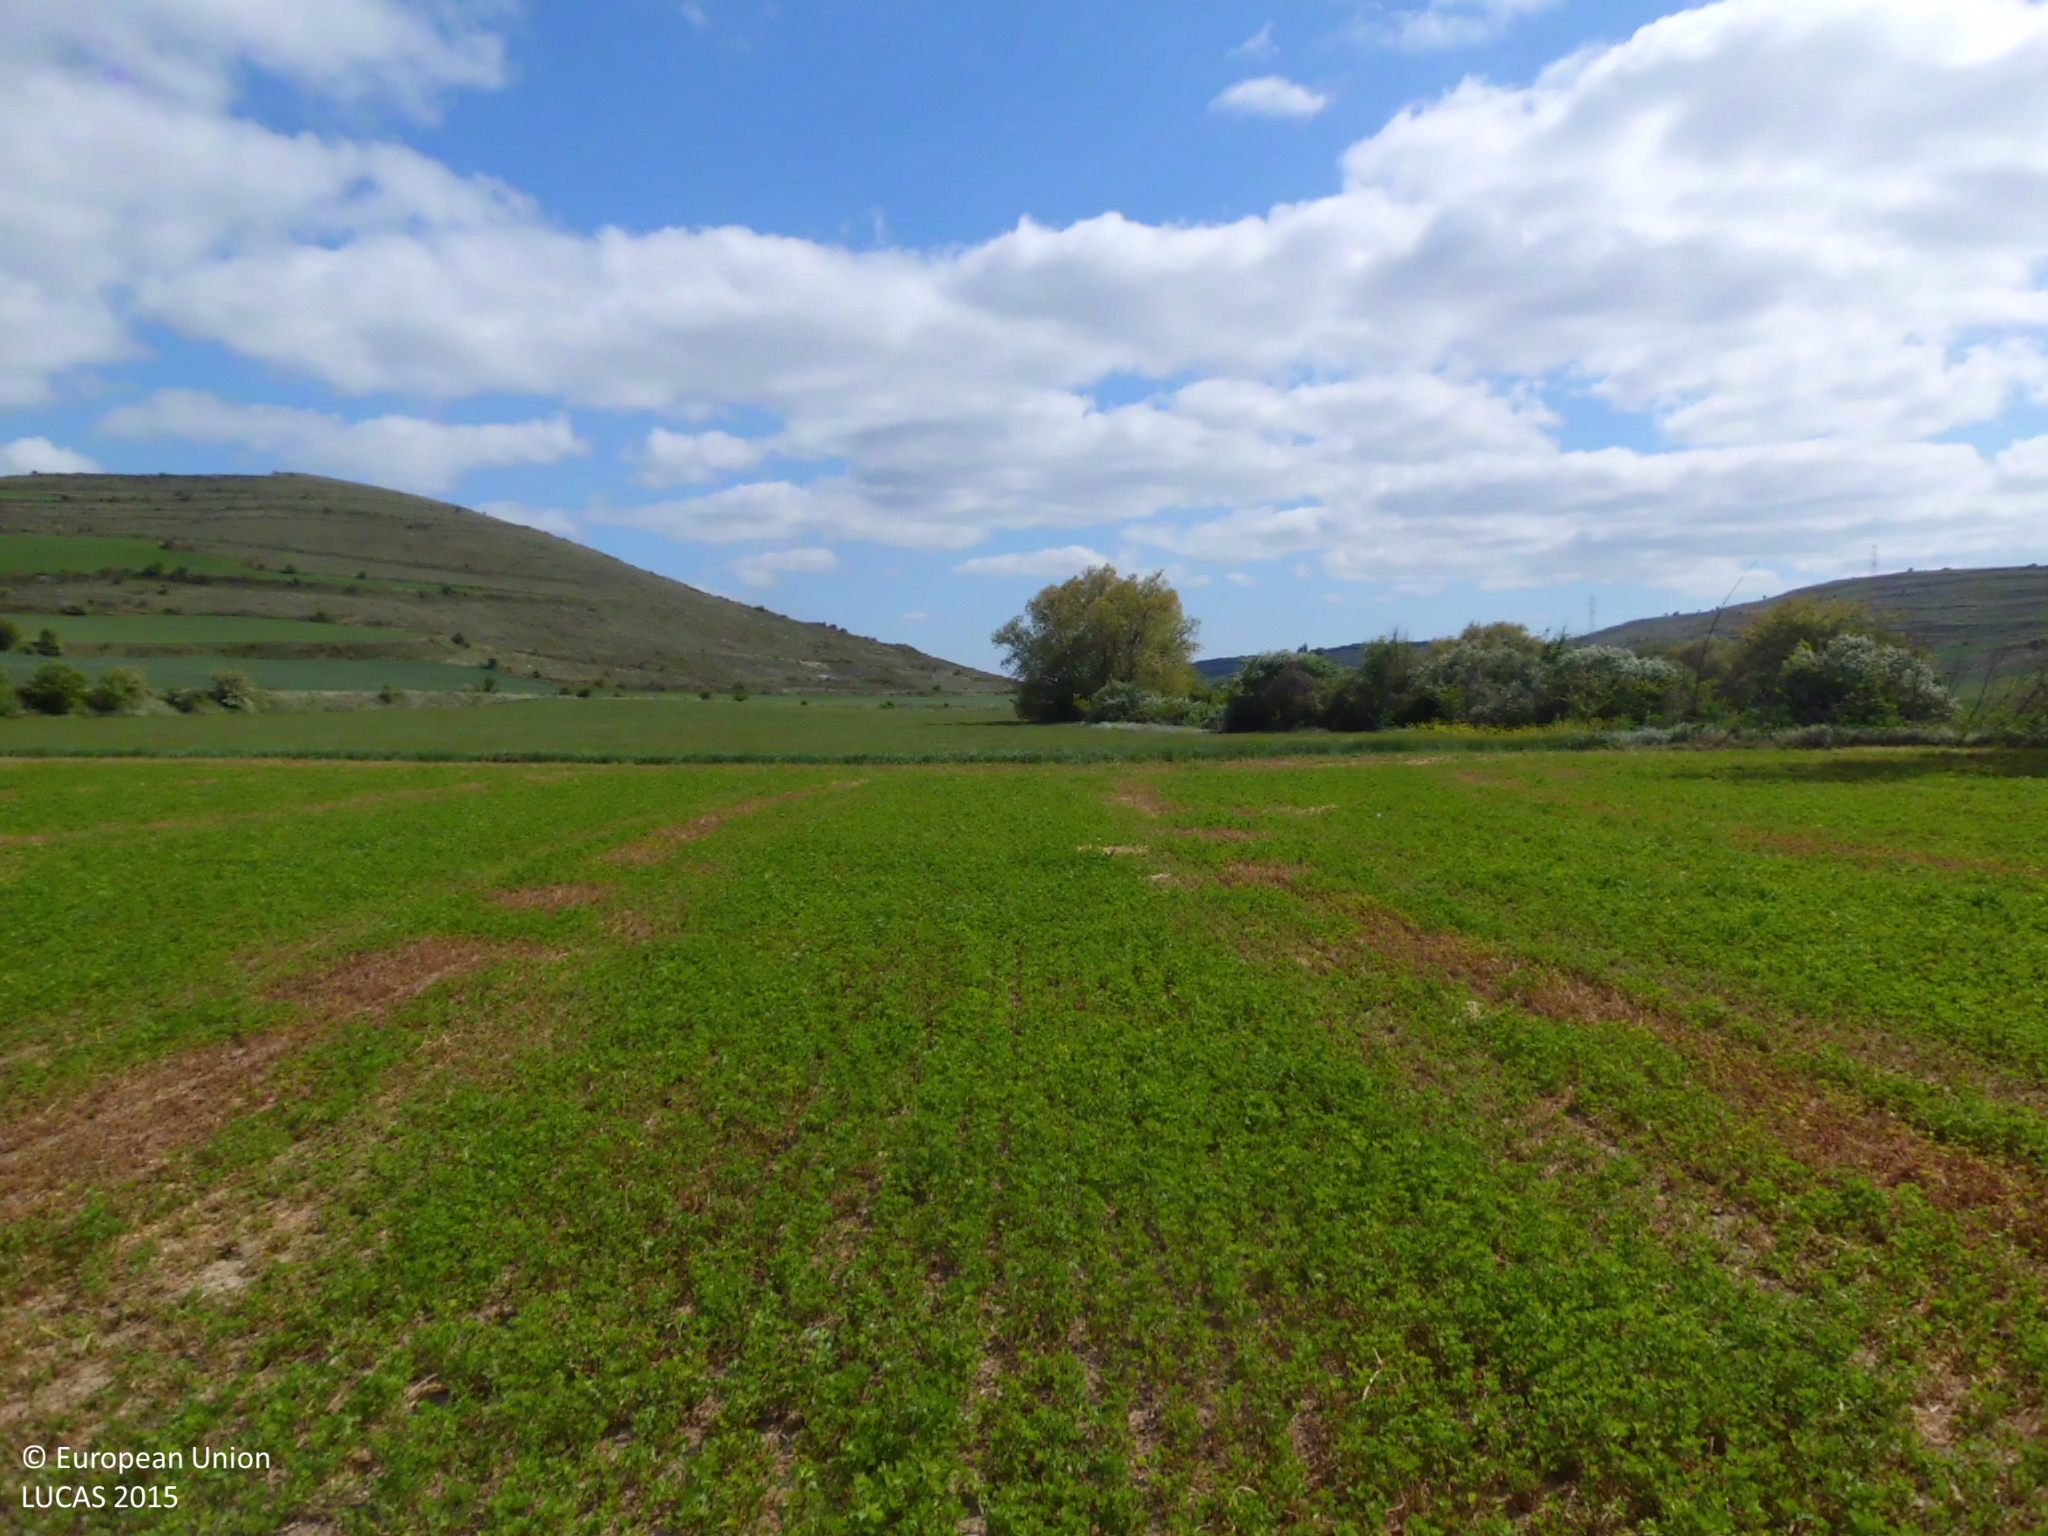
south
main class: Cropland
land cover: Lucerne
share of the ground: > 75 %
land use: Agriculture (excluding fallow land and kitchen gardens)
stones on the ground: 10 - 25 %
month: May
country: ES
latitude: 42.4179
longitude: -3.9311
